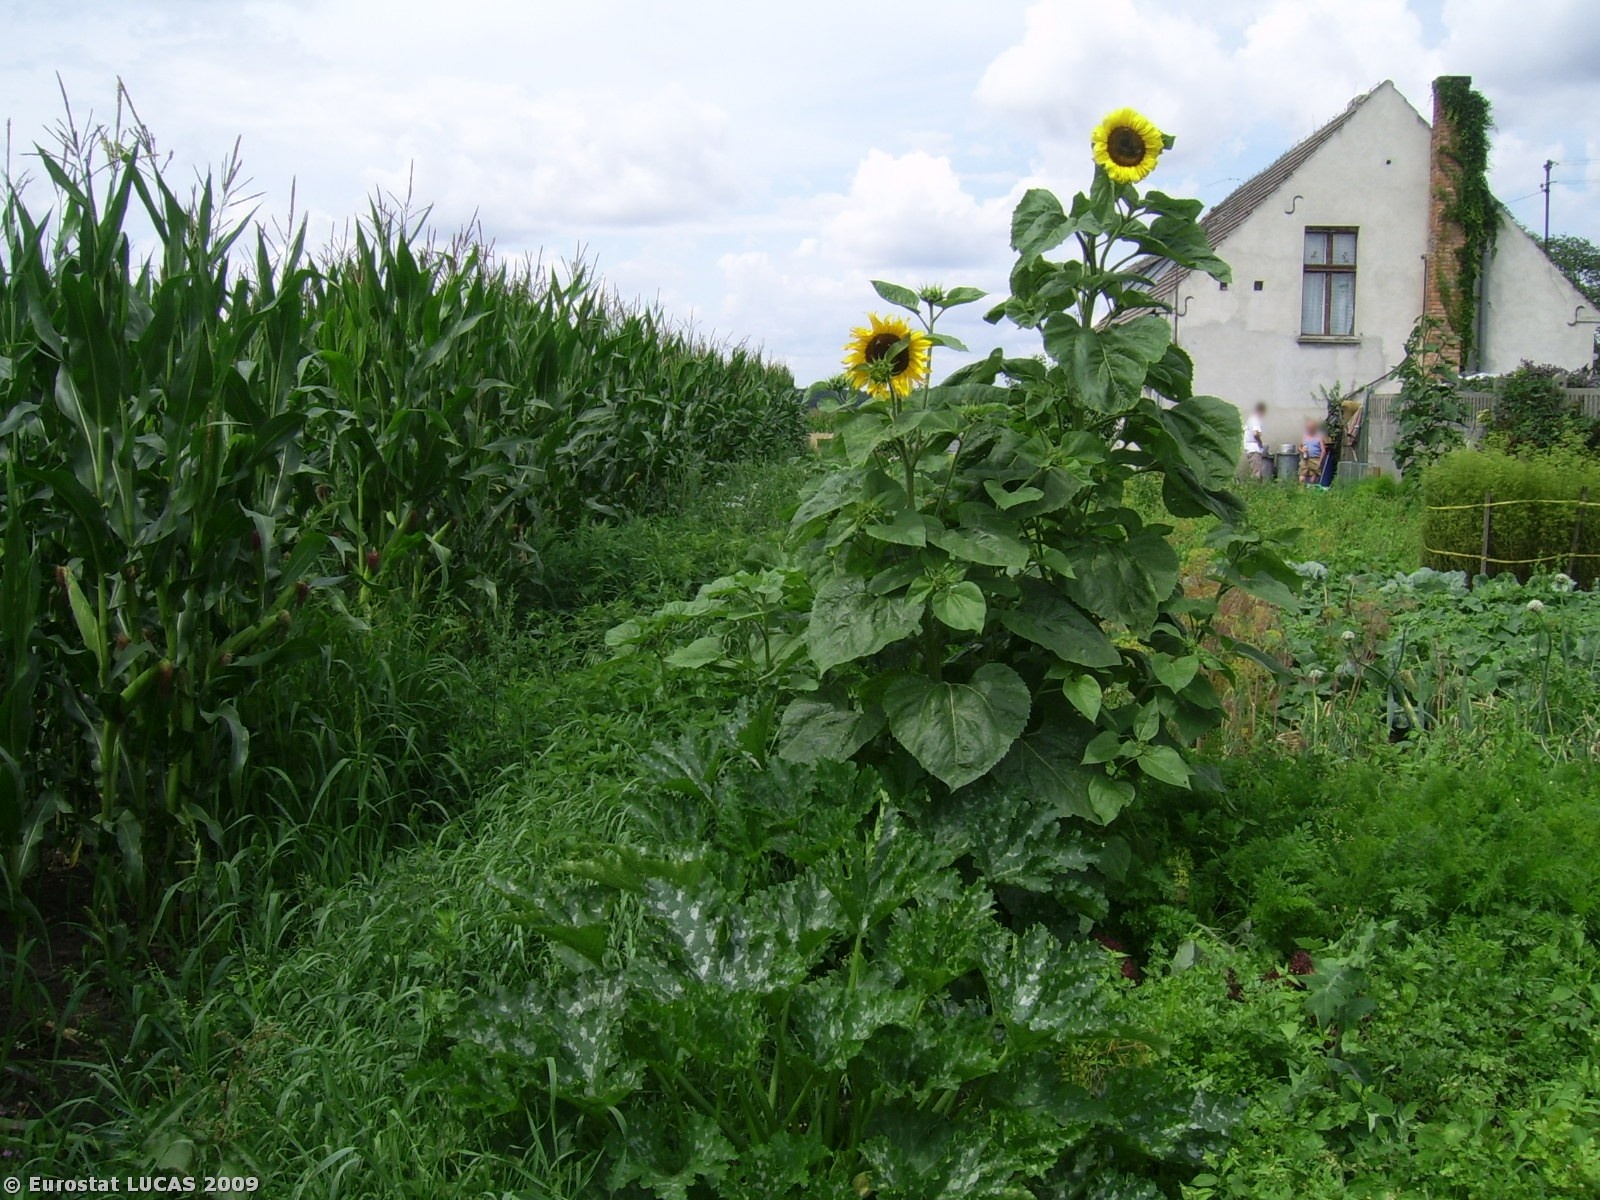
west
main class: Cropland
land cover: Maize
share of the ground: > 75 %
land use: Agriculture (excluding fallow land and kitchen gardens)
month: July
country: PL
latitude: 51.6566
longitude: 16.8466
